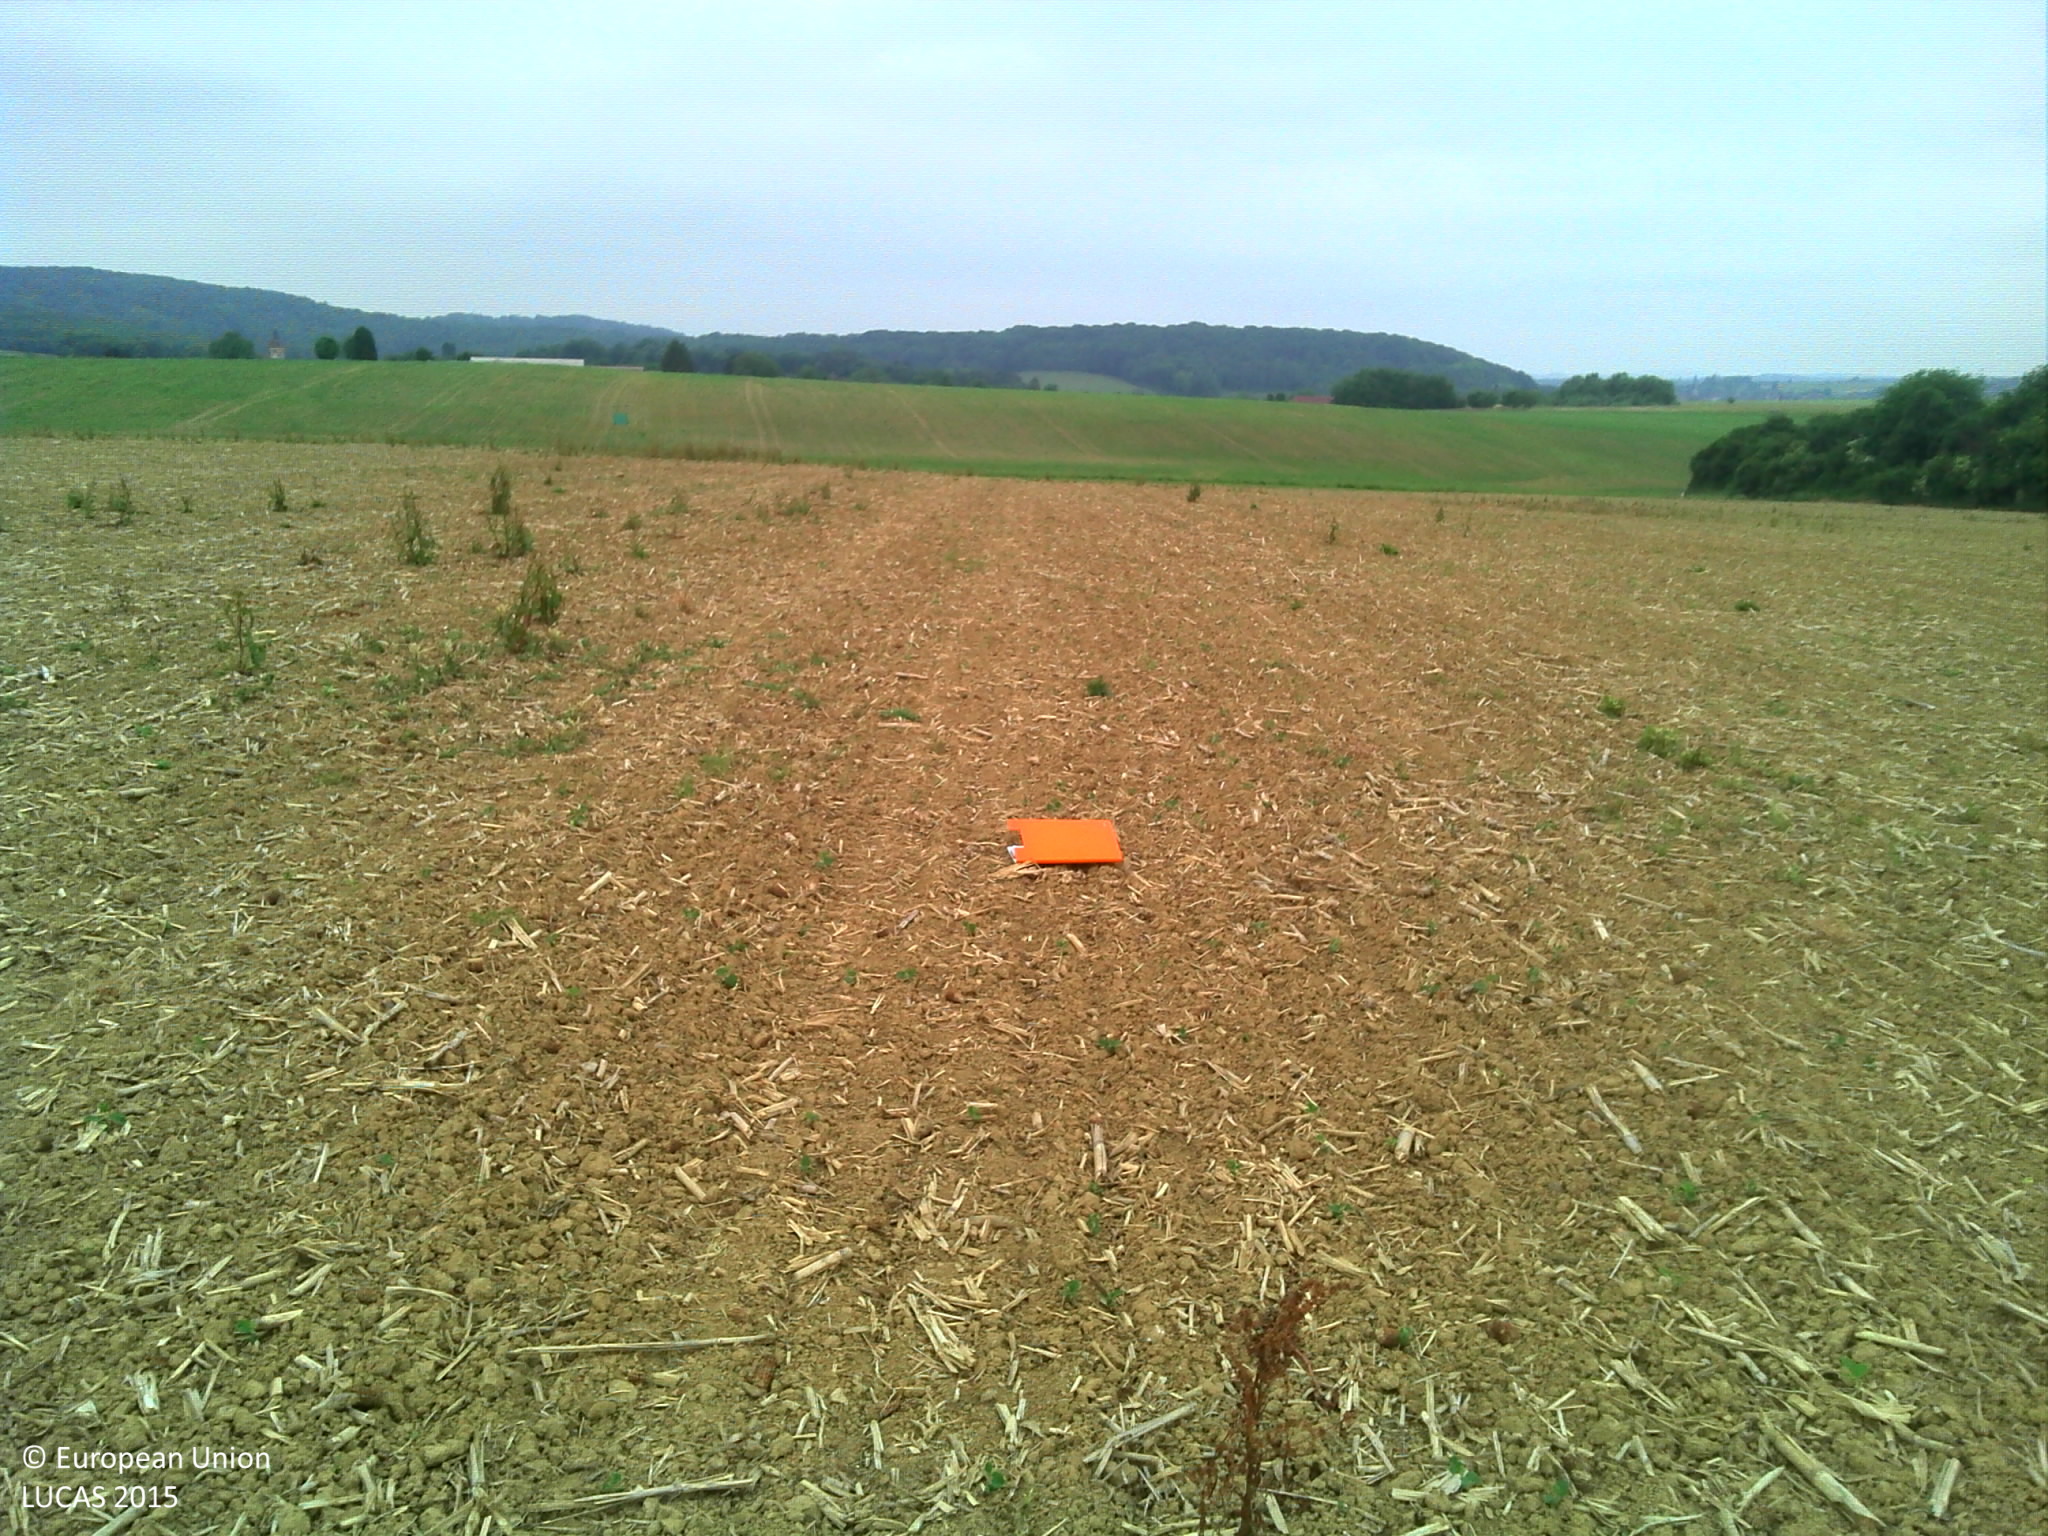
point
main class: Cropland
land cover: Soya
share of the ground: < 10 %
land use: Agriculture (excluding fallow land and kitchen gardens)
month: June
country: FR
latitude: 47.7598
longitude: 6.1455
